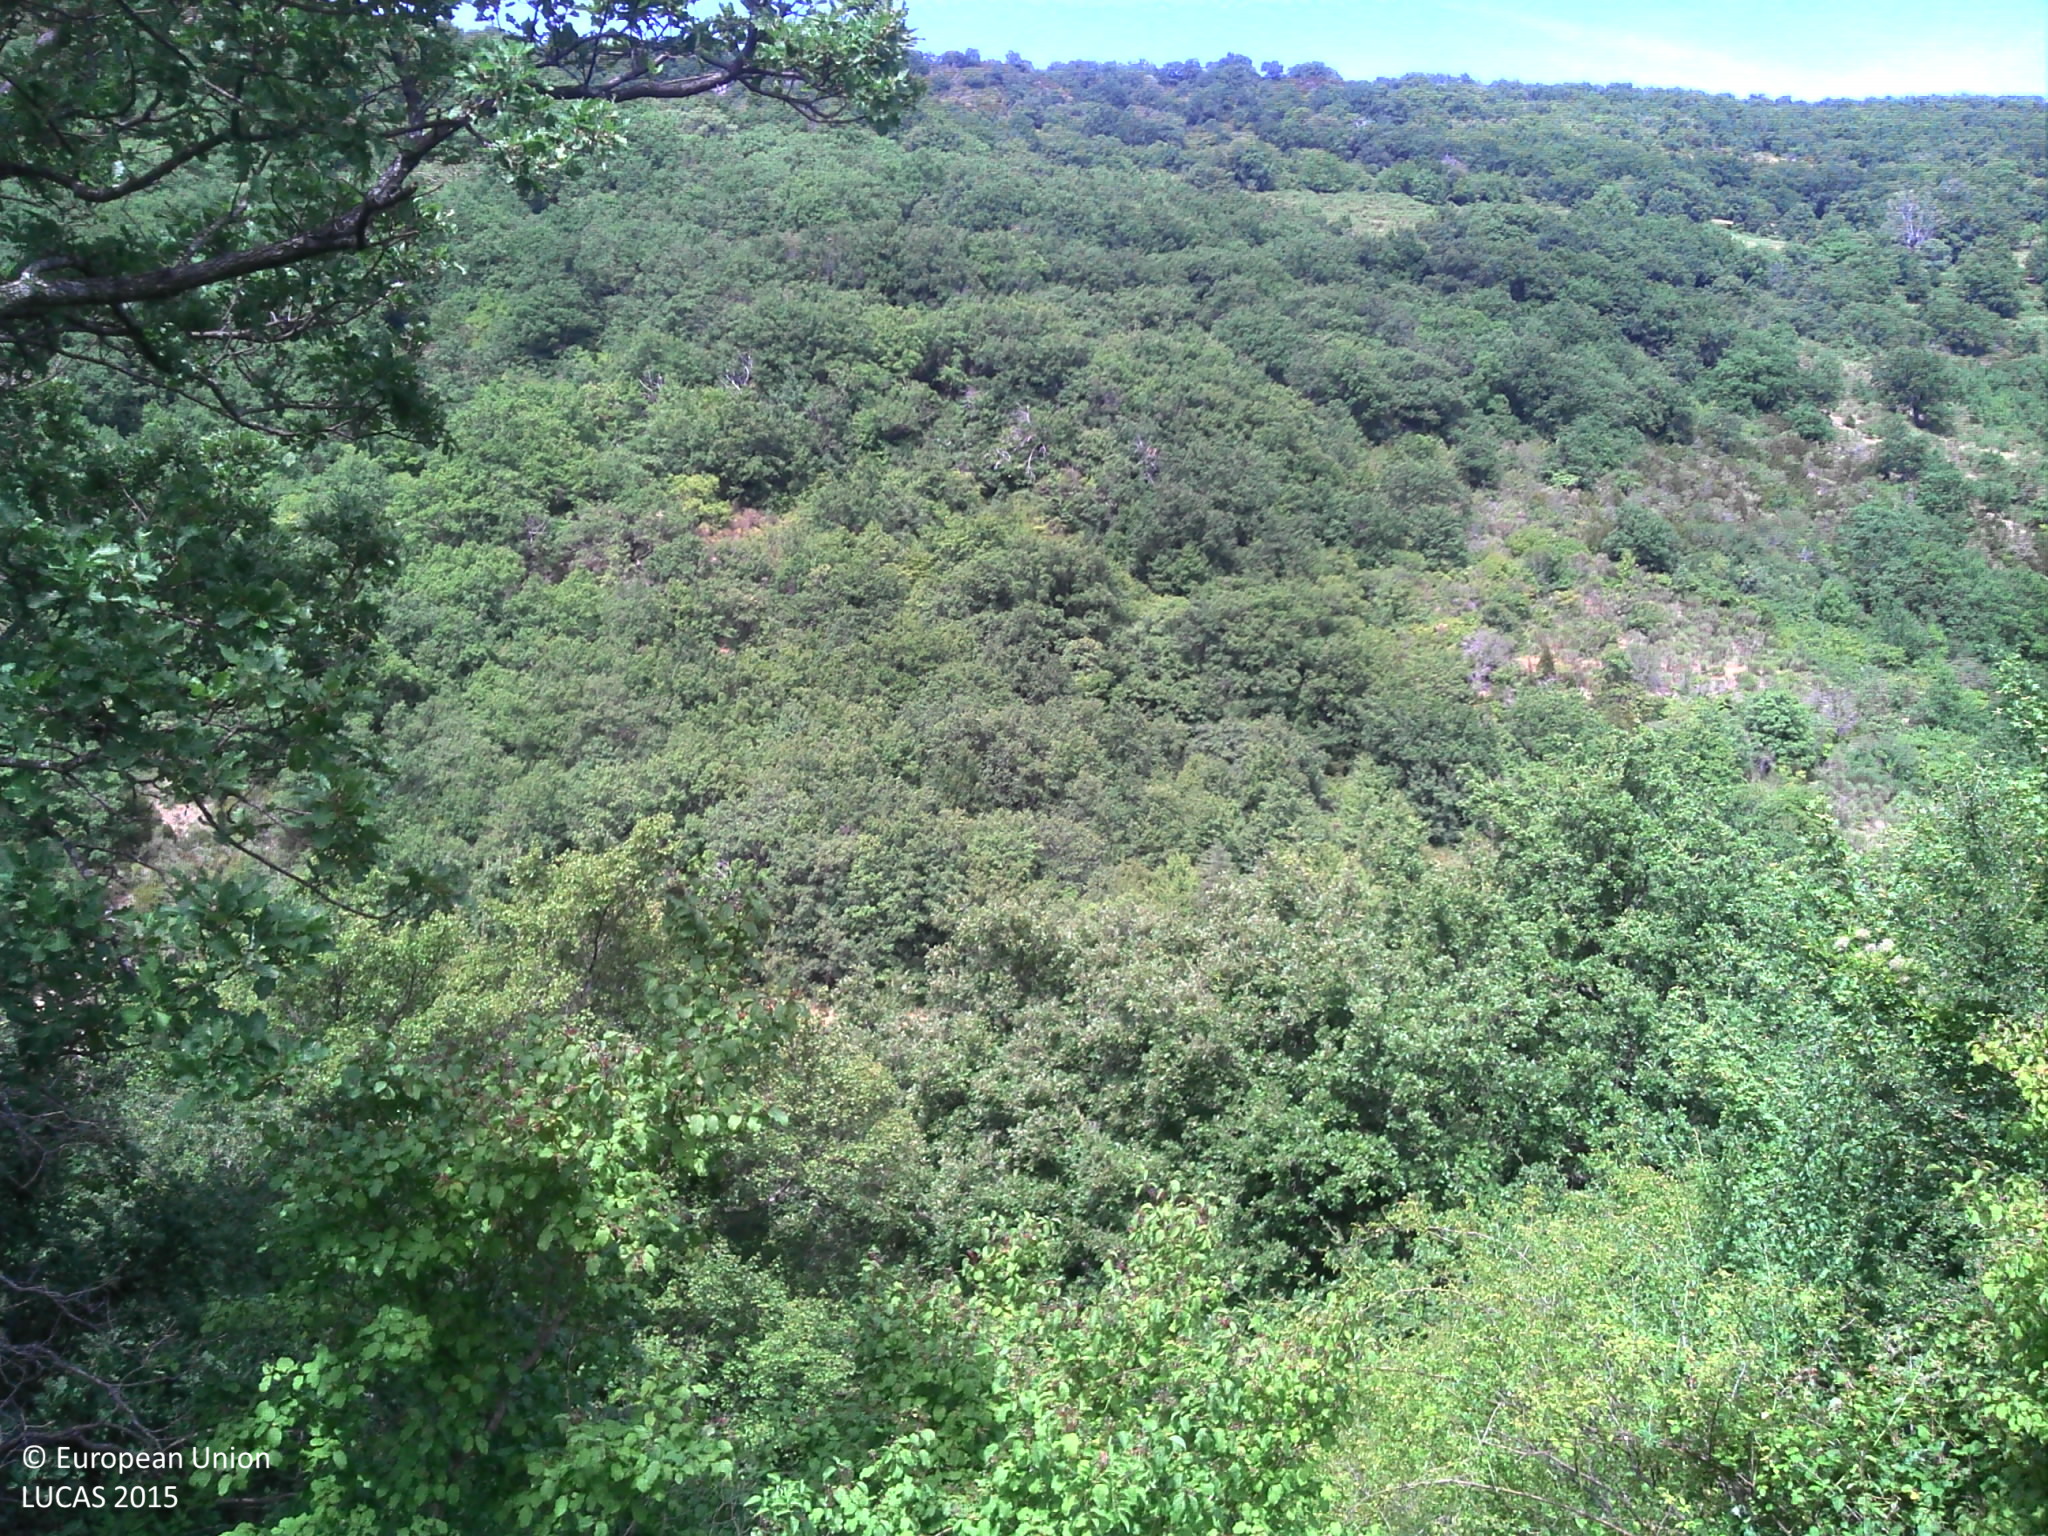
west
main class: Woodland
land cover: Broadleaved woodland
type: broadleaved evergreen forest
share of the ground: > 75 %
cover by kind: broadleaved forest trees 80 %, shrubs 10 %, herbaceous plants 10 %
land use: Semi-natural and natural areas not in use
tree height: > 5 m
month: July
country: FR
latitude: 44.6076
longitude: 4.6010
